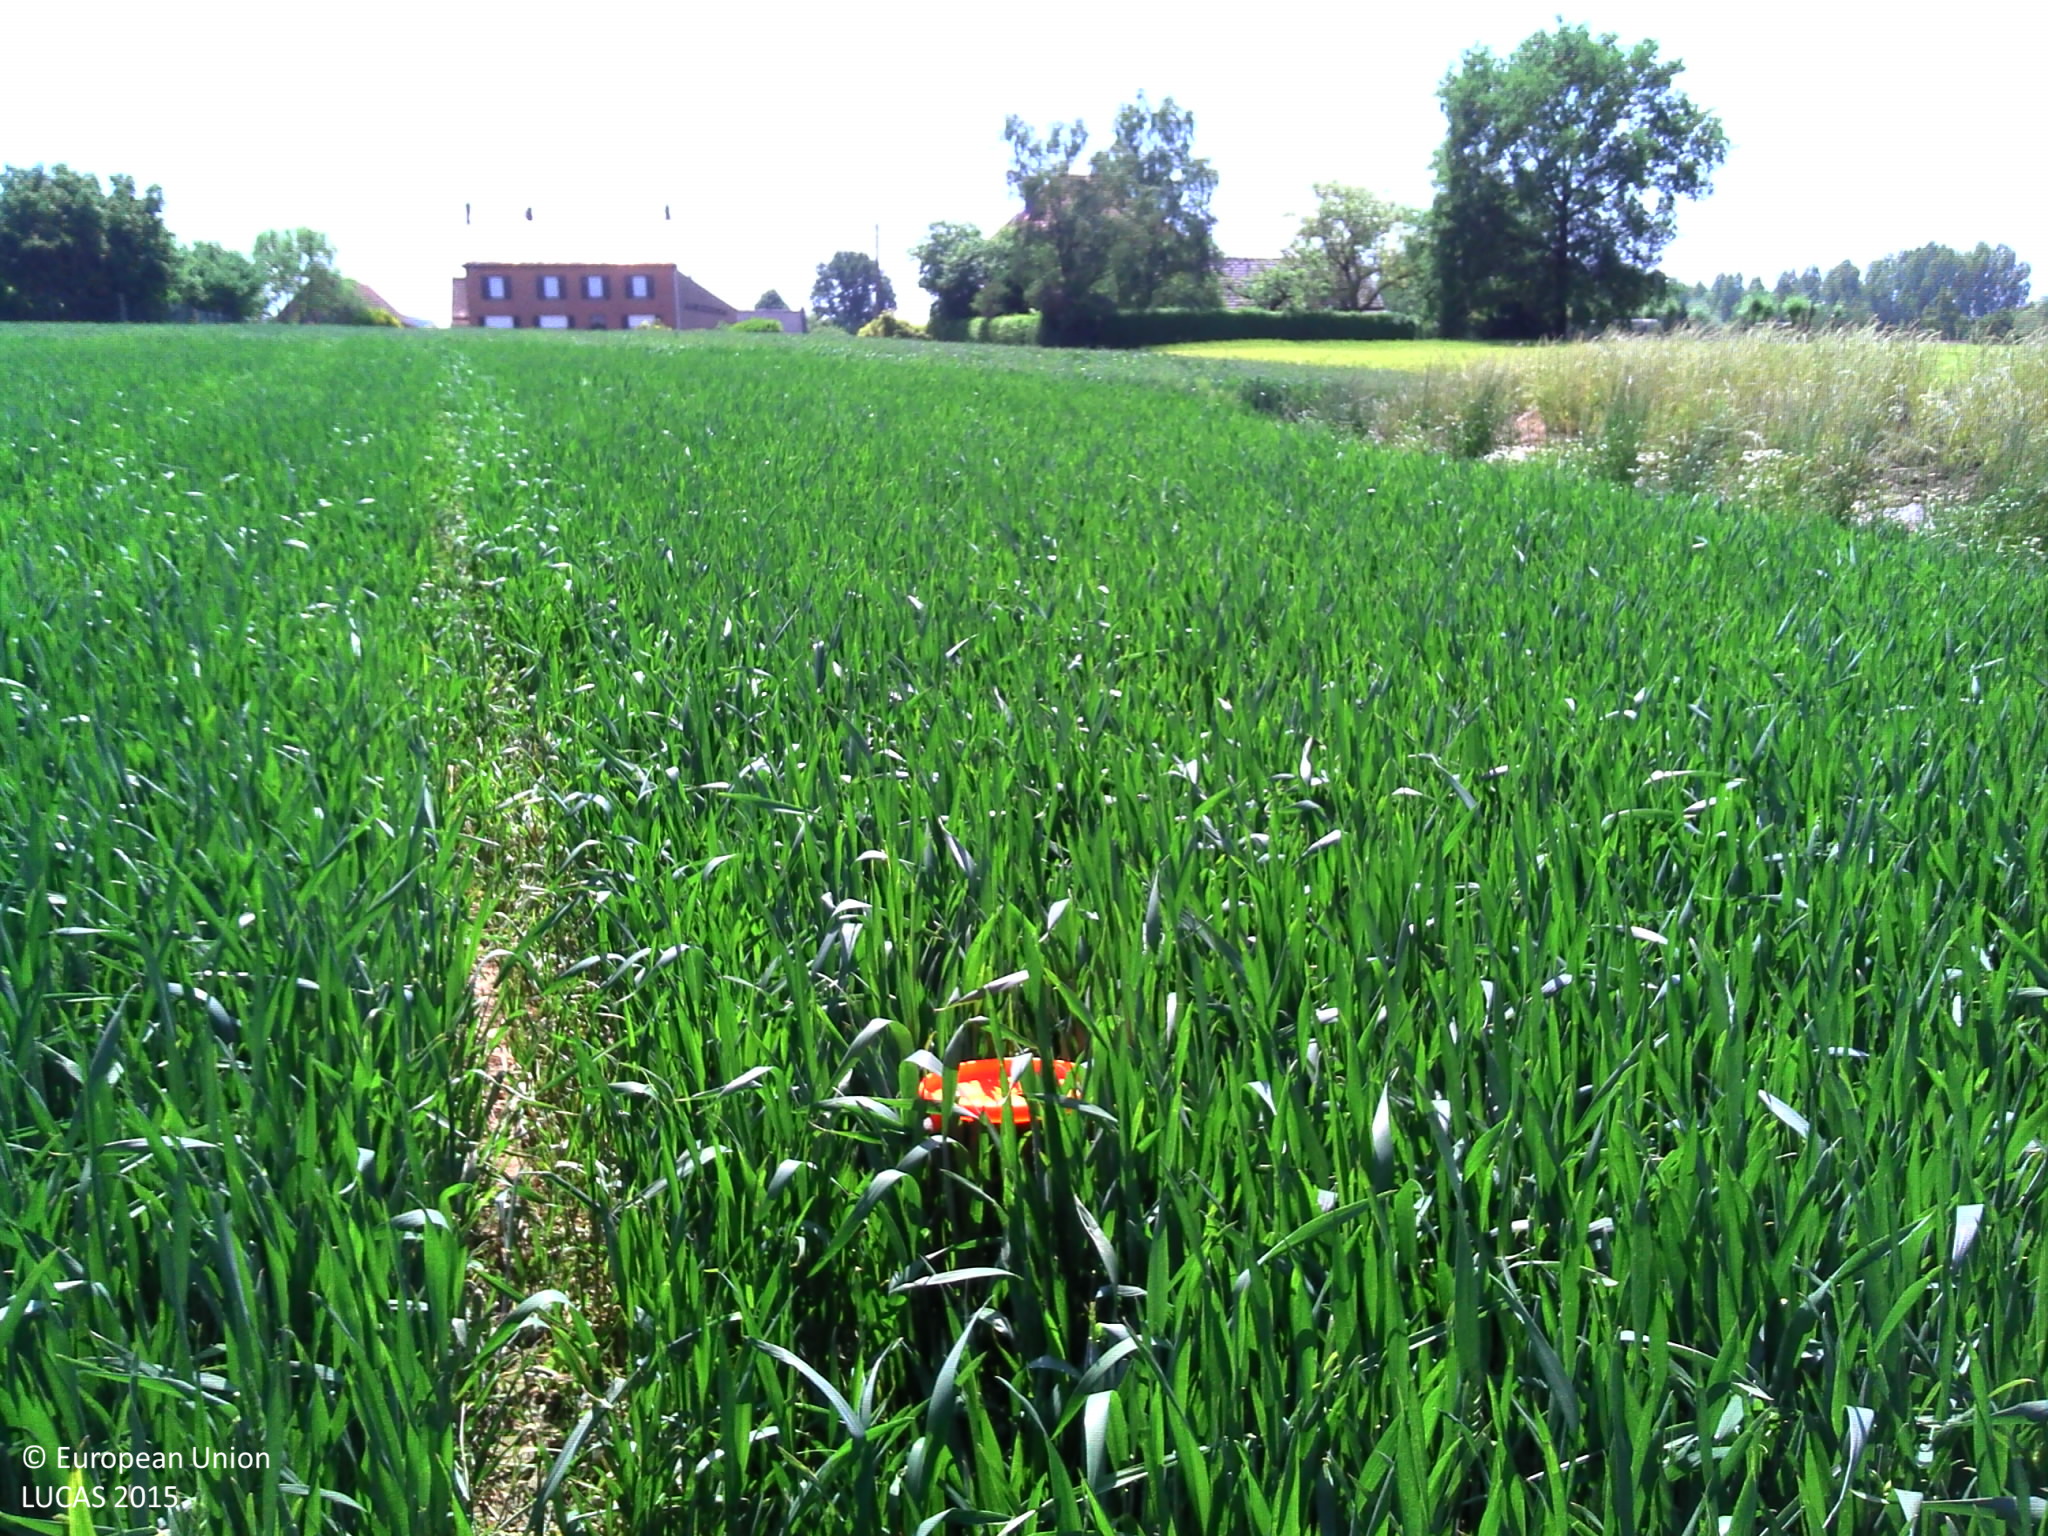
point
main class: Cropland
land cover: Common wheat
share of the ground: > 75 %
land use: Agriculture (excluding fallow land and kitchen gardens)
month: June
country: BE
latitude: 50.9175
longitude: 3.8058
